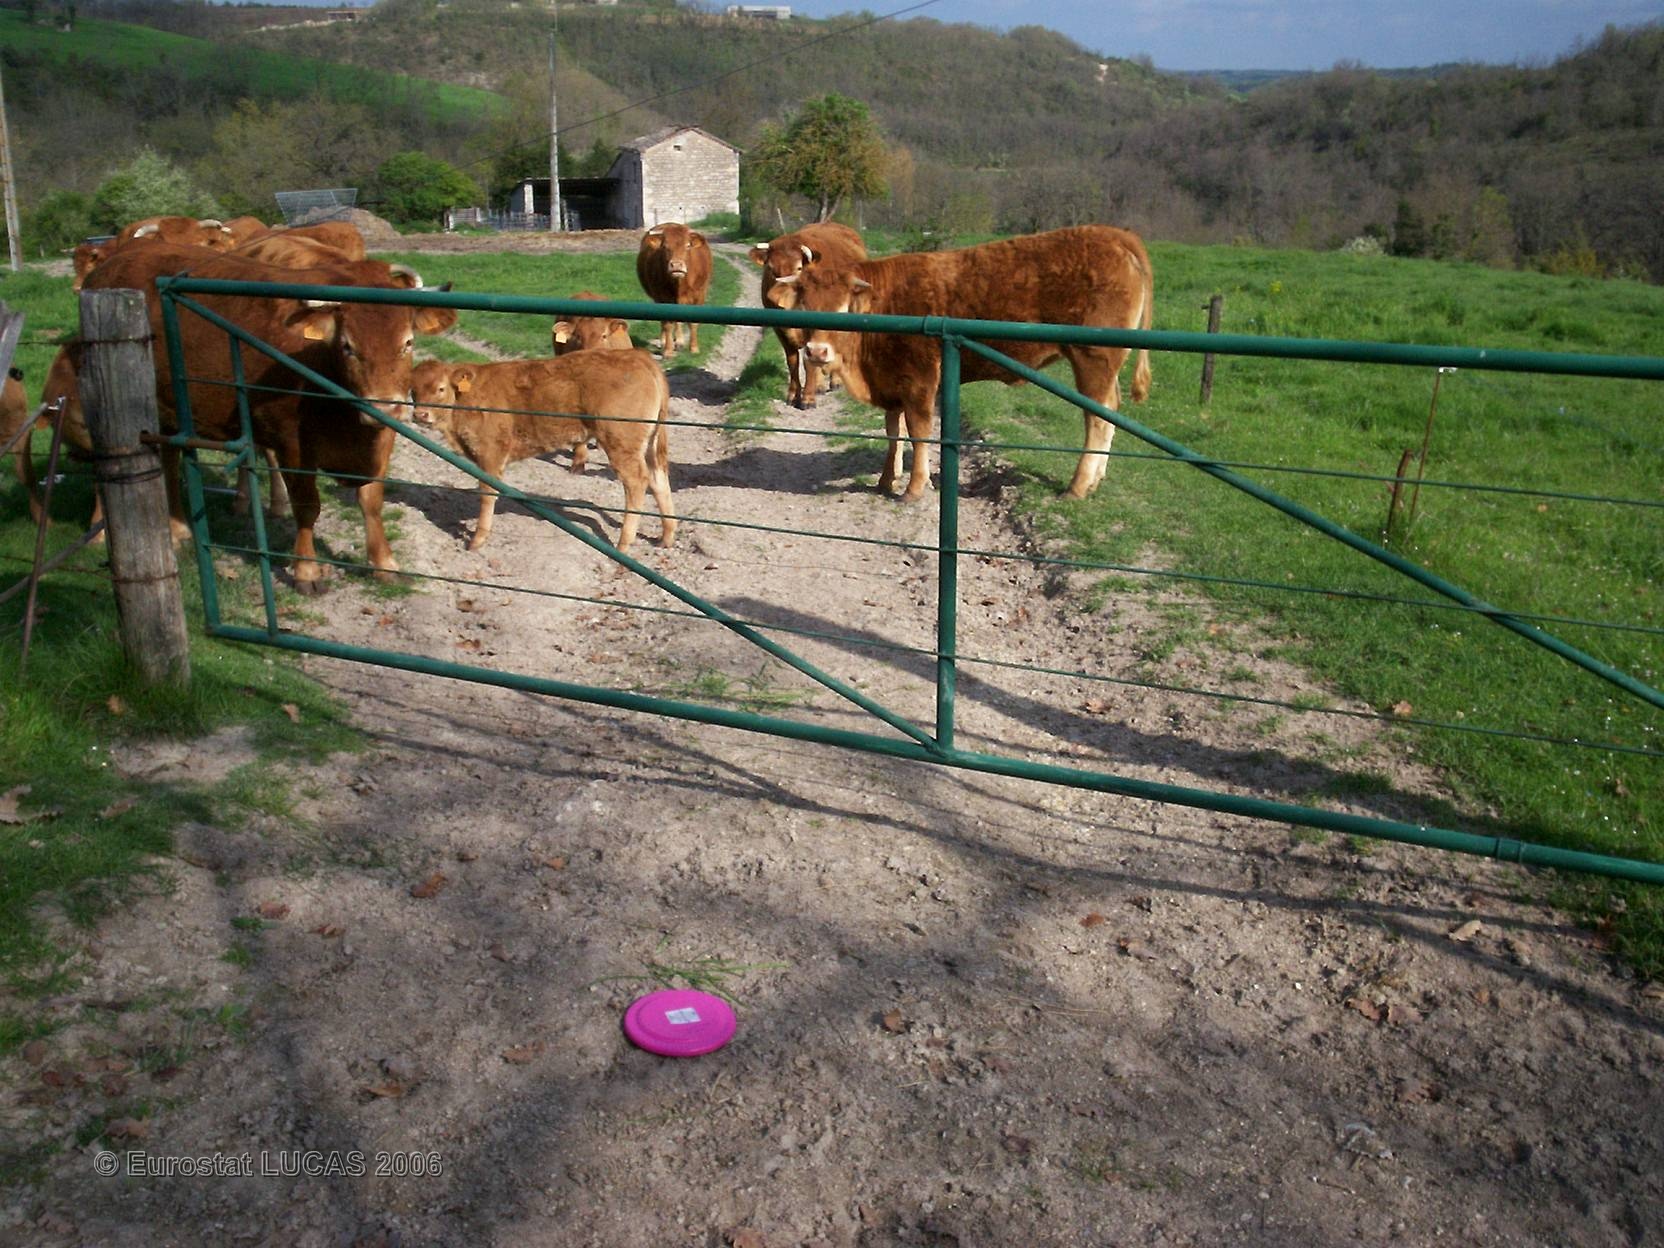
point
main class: Grassland
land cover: Grassland with sparse tree/shrub cover
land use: Agriculture (excluding fallow land and kitchen gardens)
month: April
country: FR
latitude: 44.0397
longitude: 1.9785
